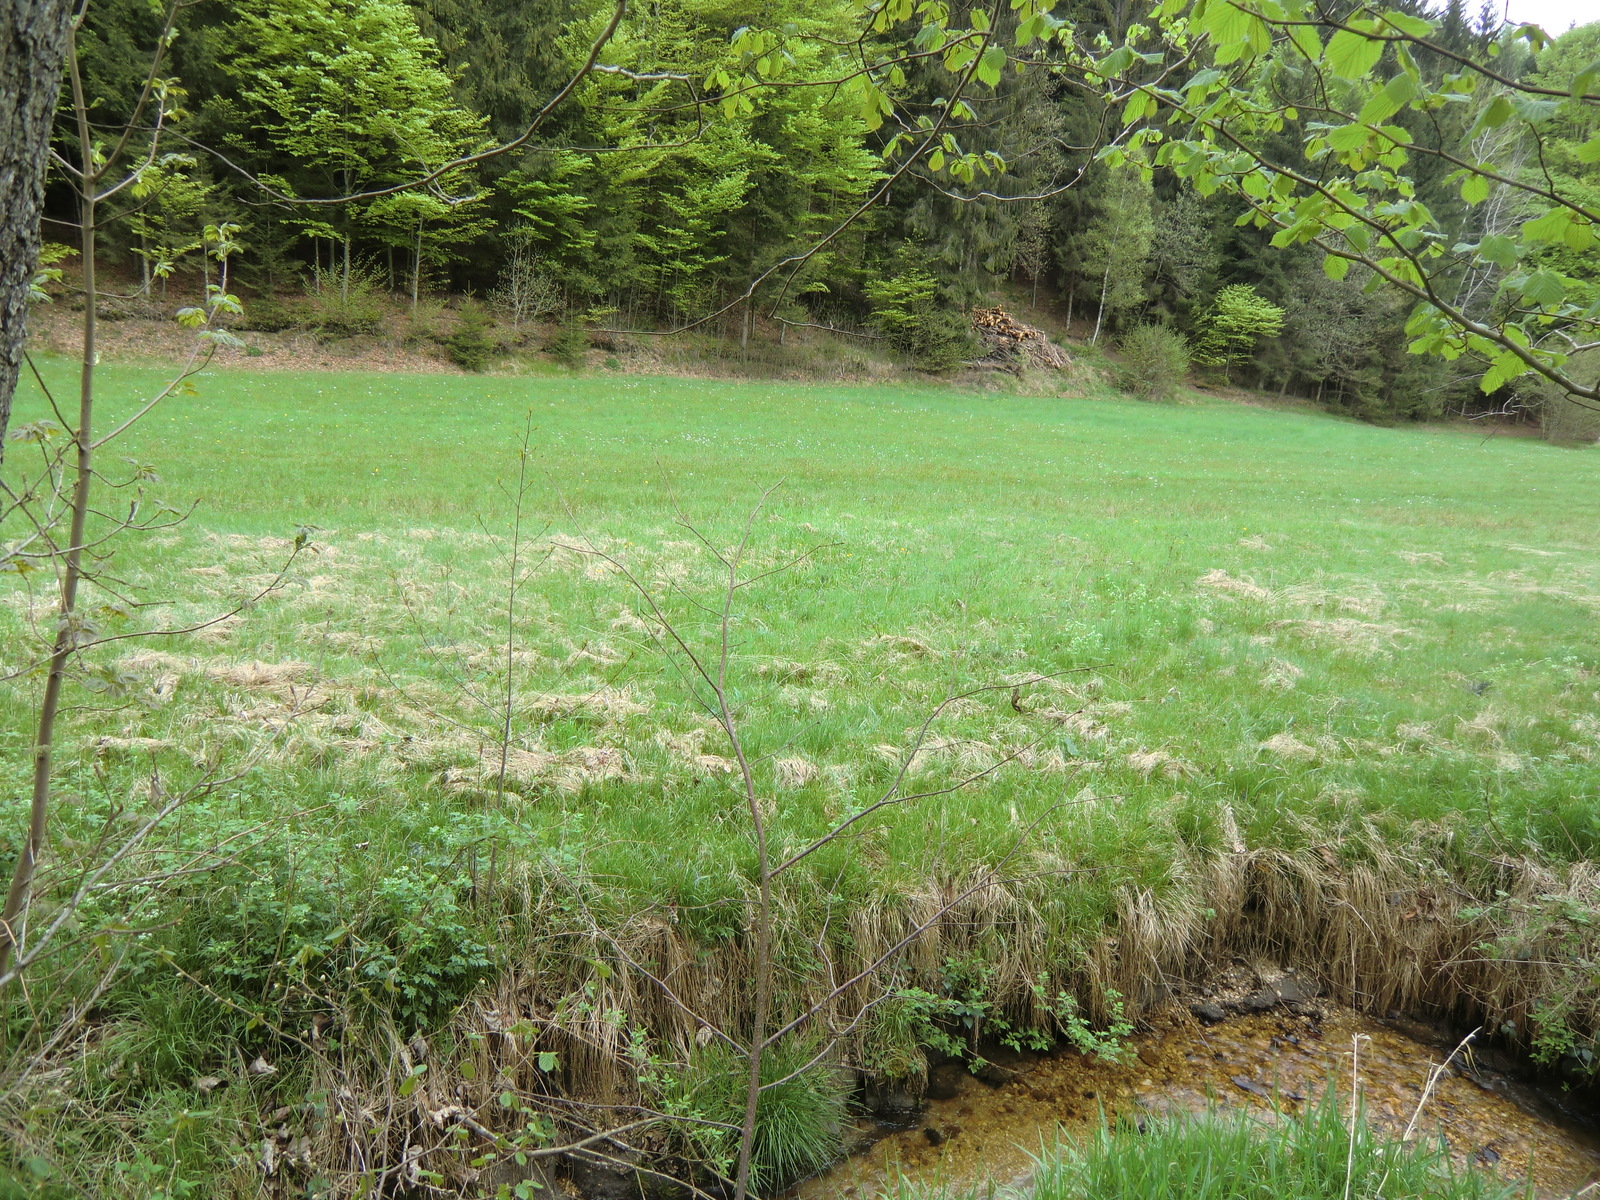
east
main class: Woodland
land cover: Broadleaved woodland
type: floodplain forest
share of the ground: 50 - 75 %
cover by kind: broadleaved forest trees 50 %, herbaceous plants 25 %, shrubs 10 %, unconsolidated bare surface 10 %, coniferous forest trees 5 %
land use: Forestry
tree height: > 5 m
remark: Temporary flooded
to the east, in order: Broadleaved woodland; Rivers and streams; Grassland without tree/shrub cover; Ditches and canals; Grassland without tree/shrub cover; Spruce dominated mixed woodland; Tracks; Spruce dominated mixed woodland; Tracks; Spruce dominated coniferous woodland; Tracks; Spruce dominated coniferous woodland; Tracks; Spruce dominated coniferous woodland; Spruce dominated mixed woodland
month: May
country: AT
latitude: 48.3358
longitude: 14.7900
